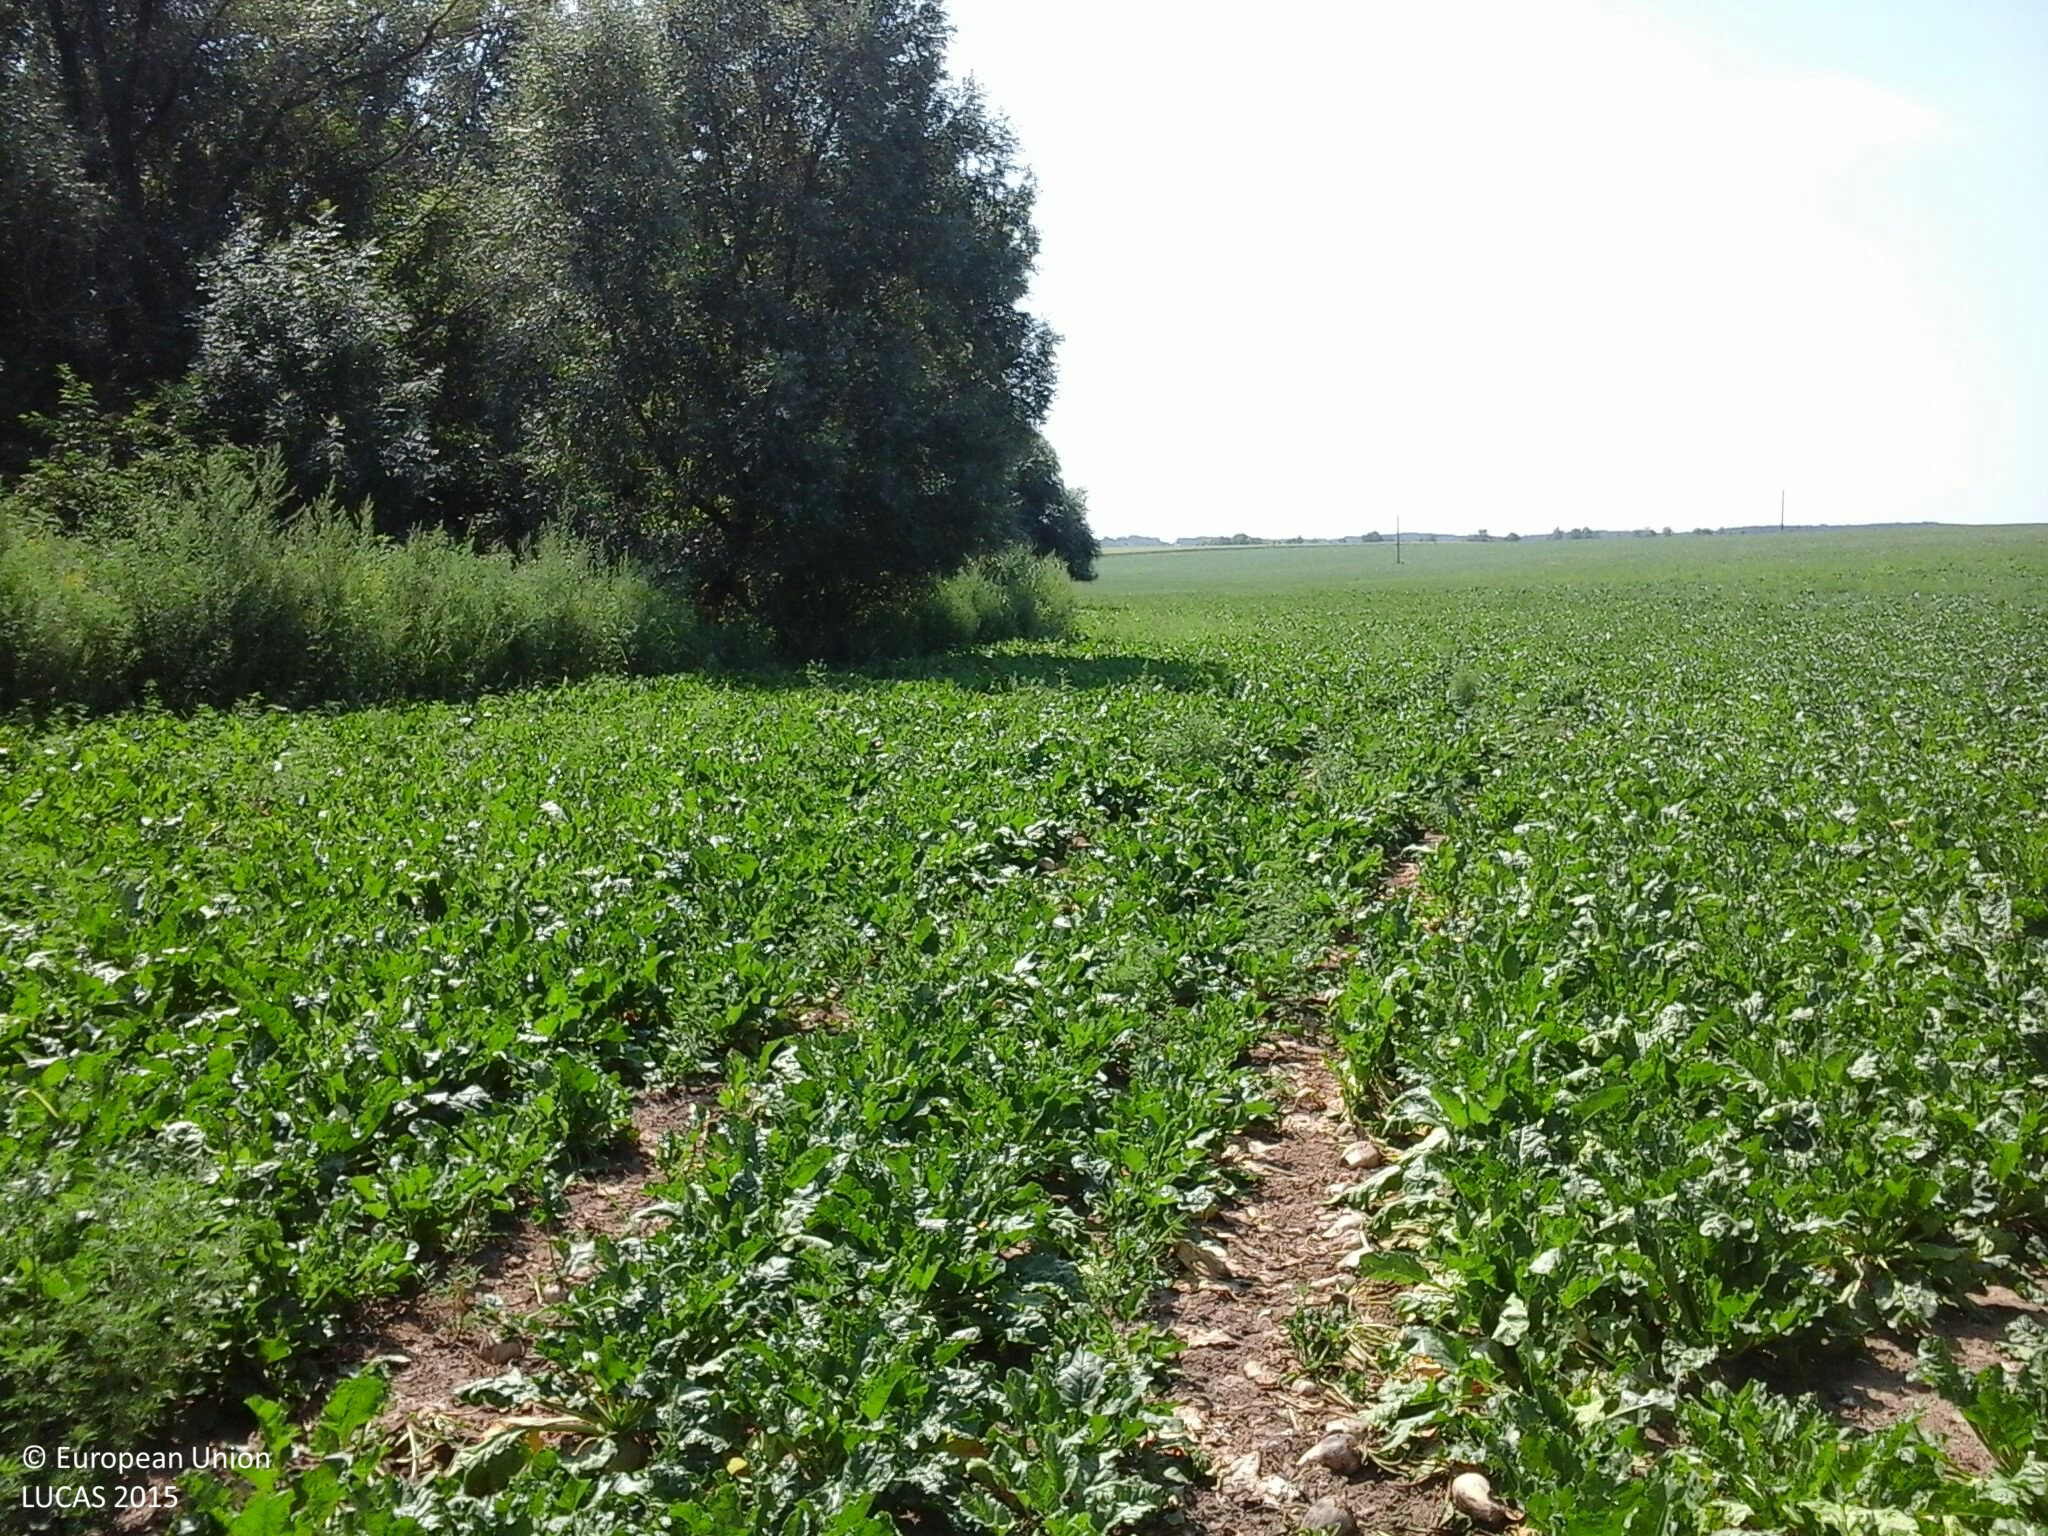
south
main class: Cropland
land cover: Sugar beet
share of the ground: > 75 %
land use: Agriculture (excluding fallow land and kitchen gardens)
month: August
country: HU
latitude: 46.6968
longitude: 18.0773
